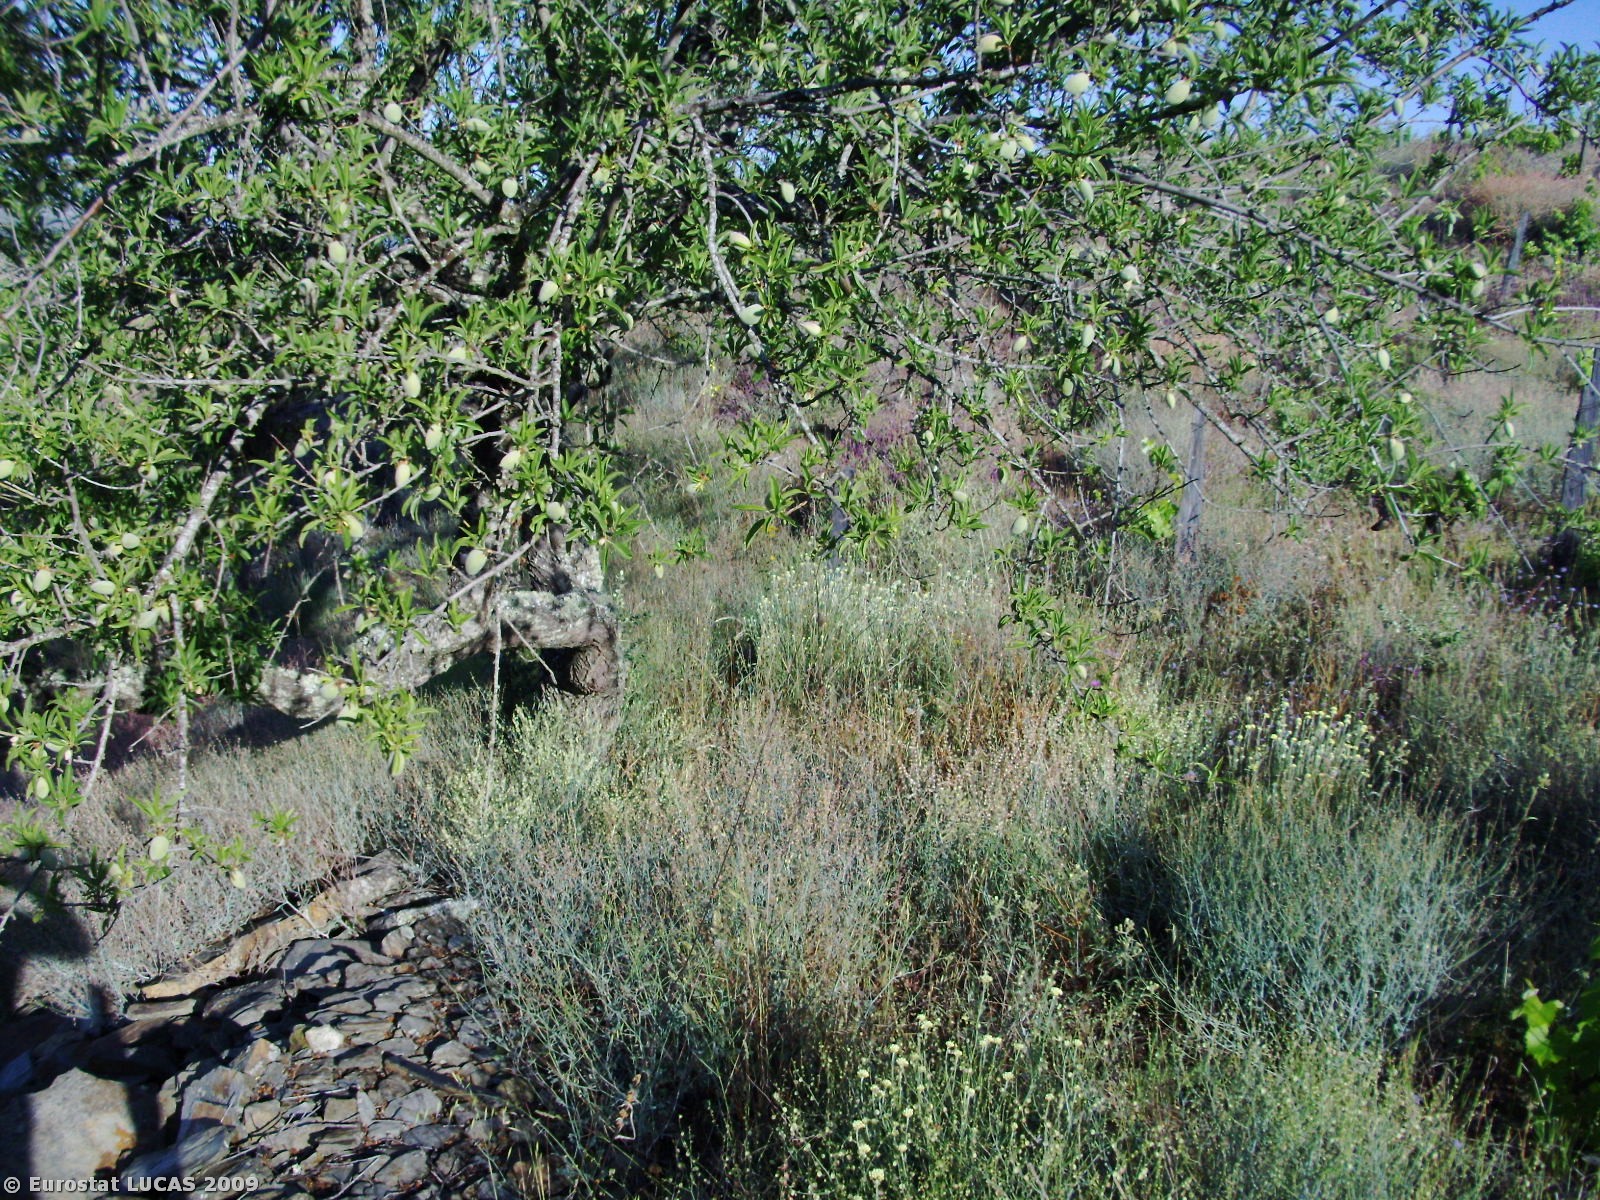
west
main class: Shrubland
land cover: Shrubland without tree cover
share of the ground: > 75 %
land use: Unused
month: May
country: PT
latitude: 41.0984
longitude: -7.3941
